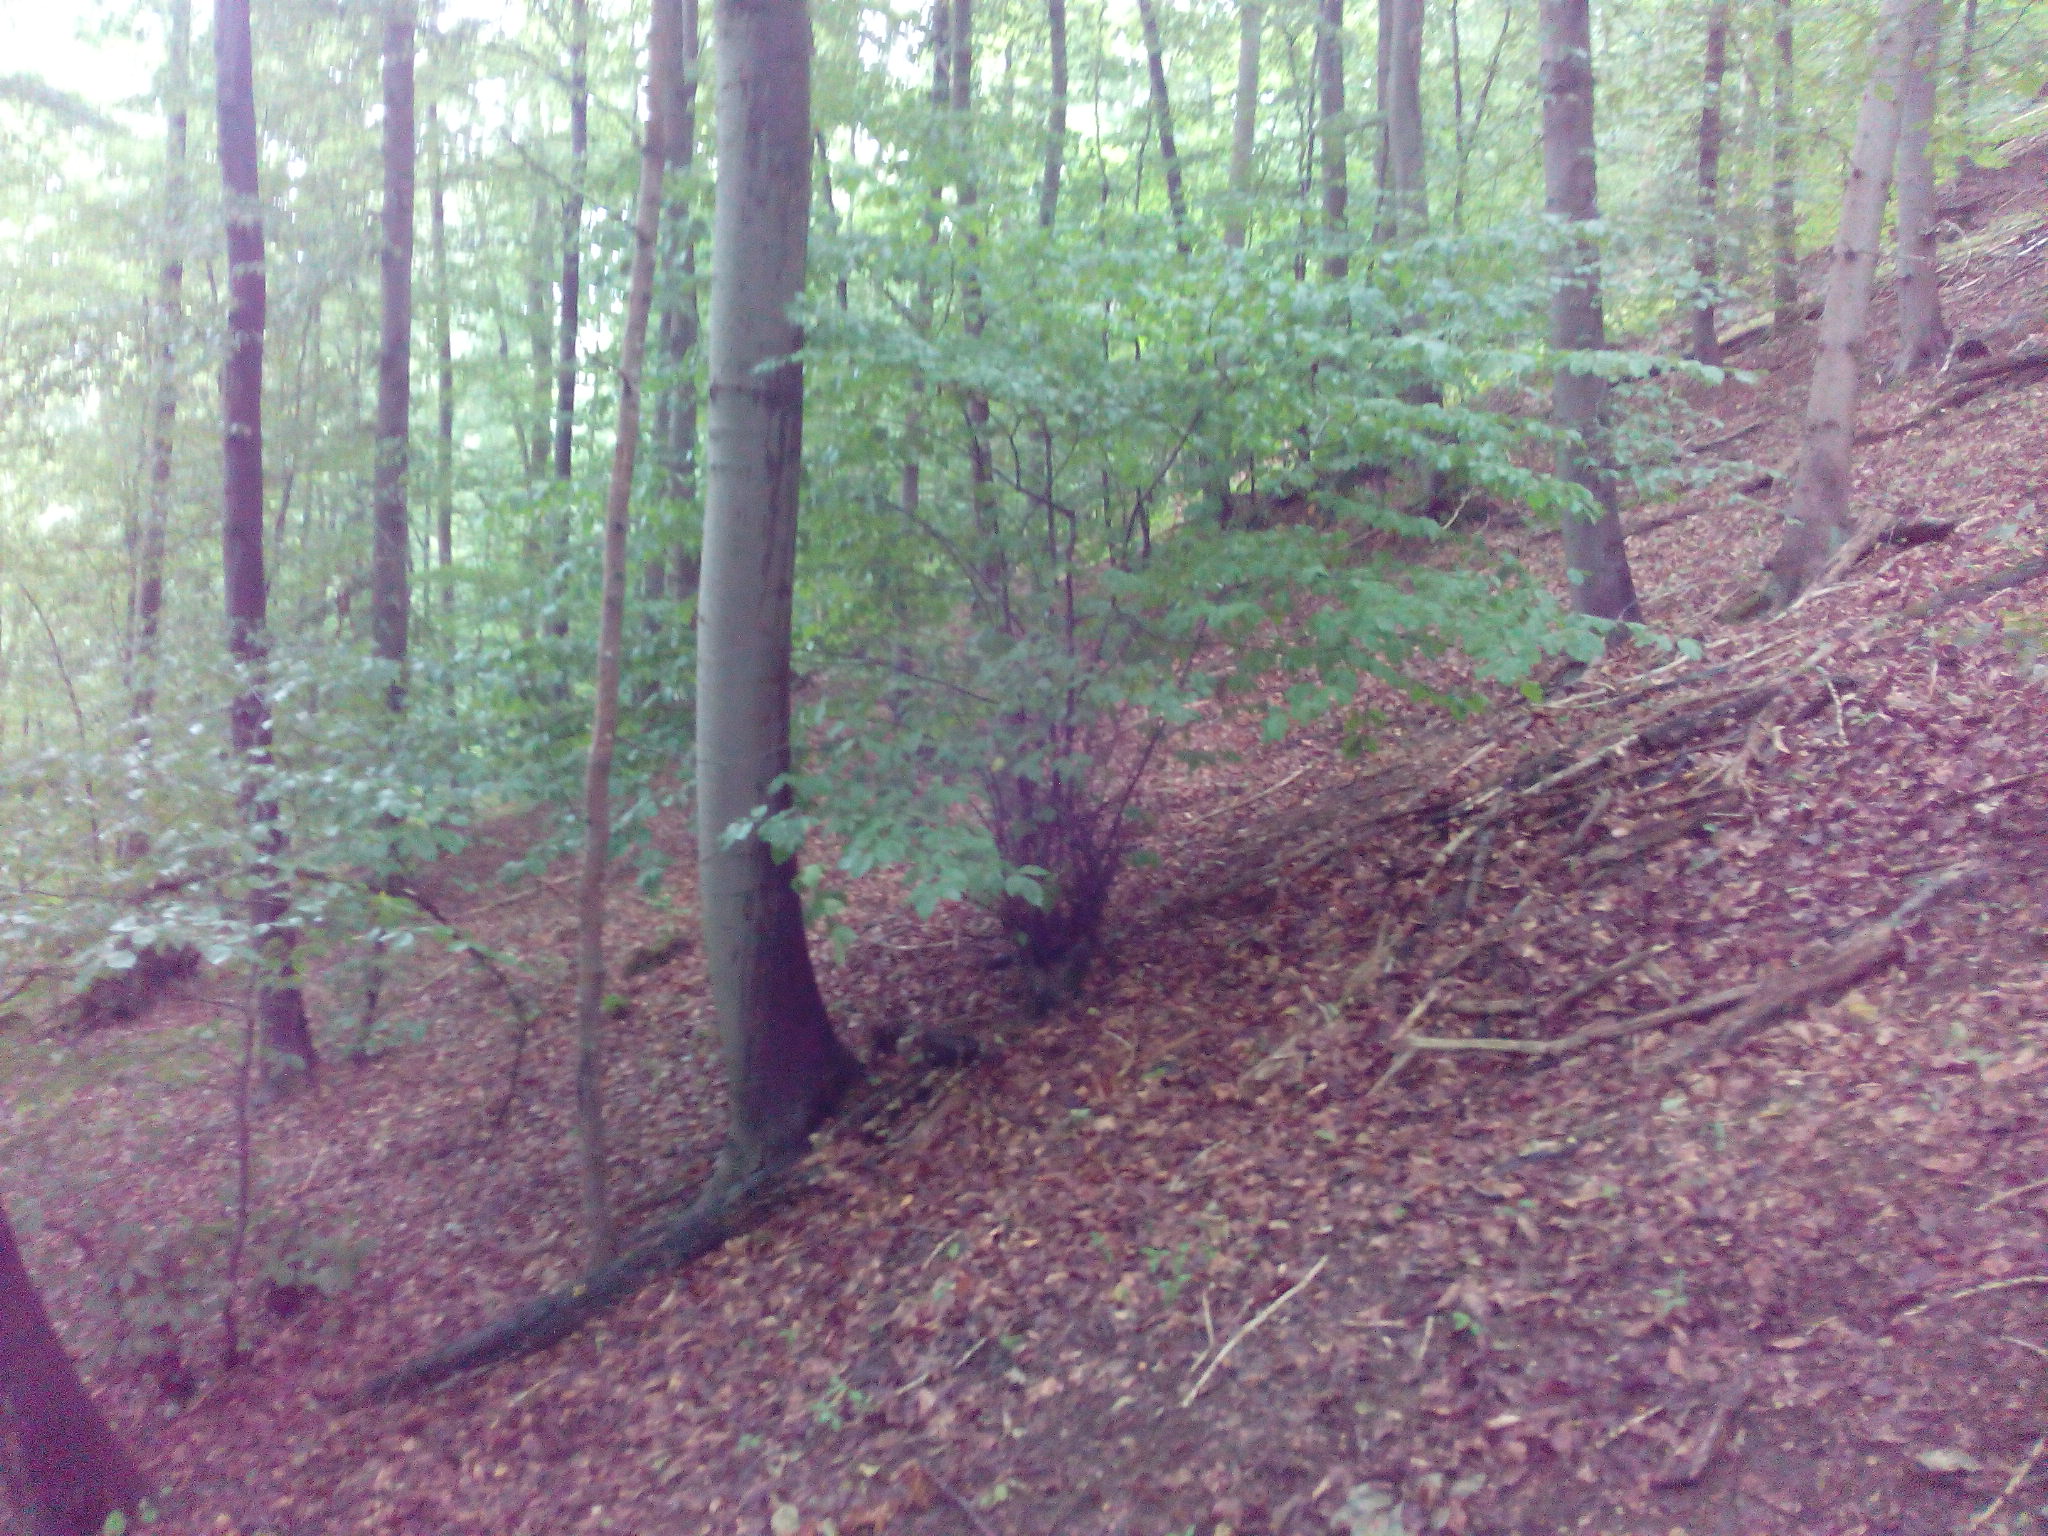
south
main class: Woodland
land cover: Broadleaved woodland
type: mesophytic deciduous forest
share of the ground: > 75 %
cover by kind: broadleaved forest trees 90 %, herbaceous plants 10 %
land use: Forestry
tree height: > 5 m
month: August
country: DE
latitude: 52.1437
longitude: 9.8977
